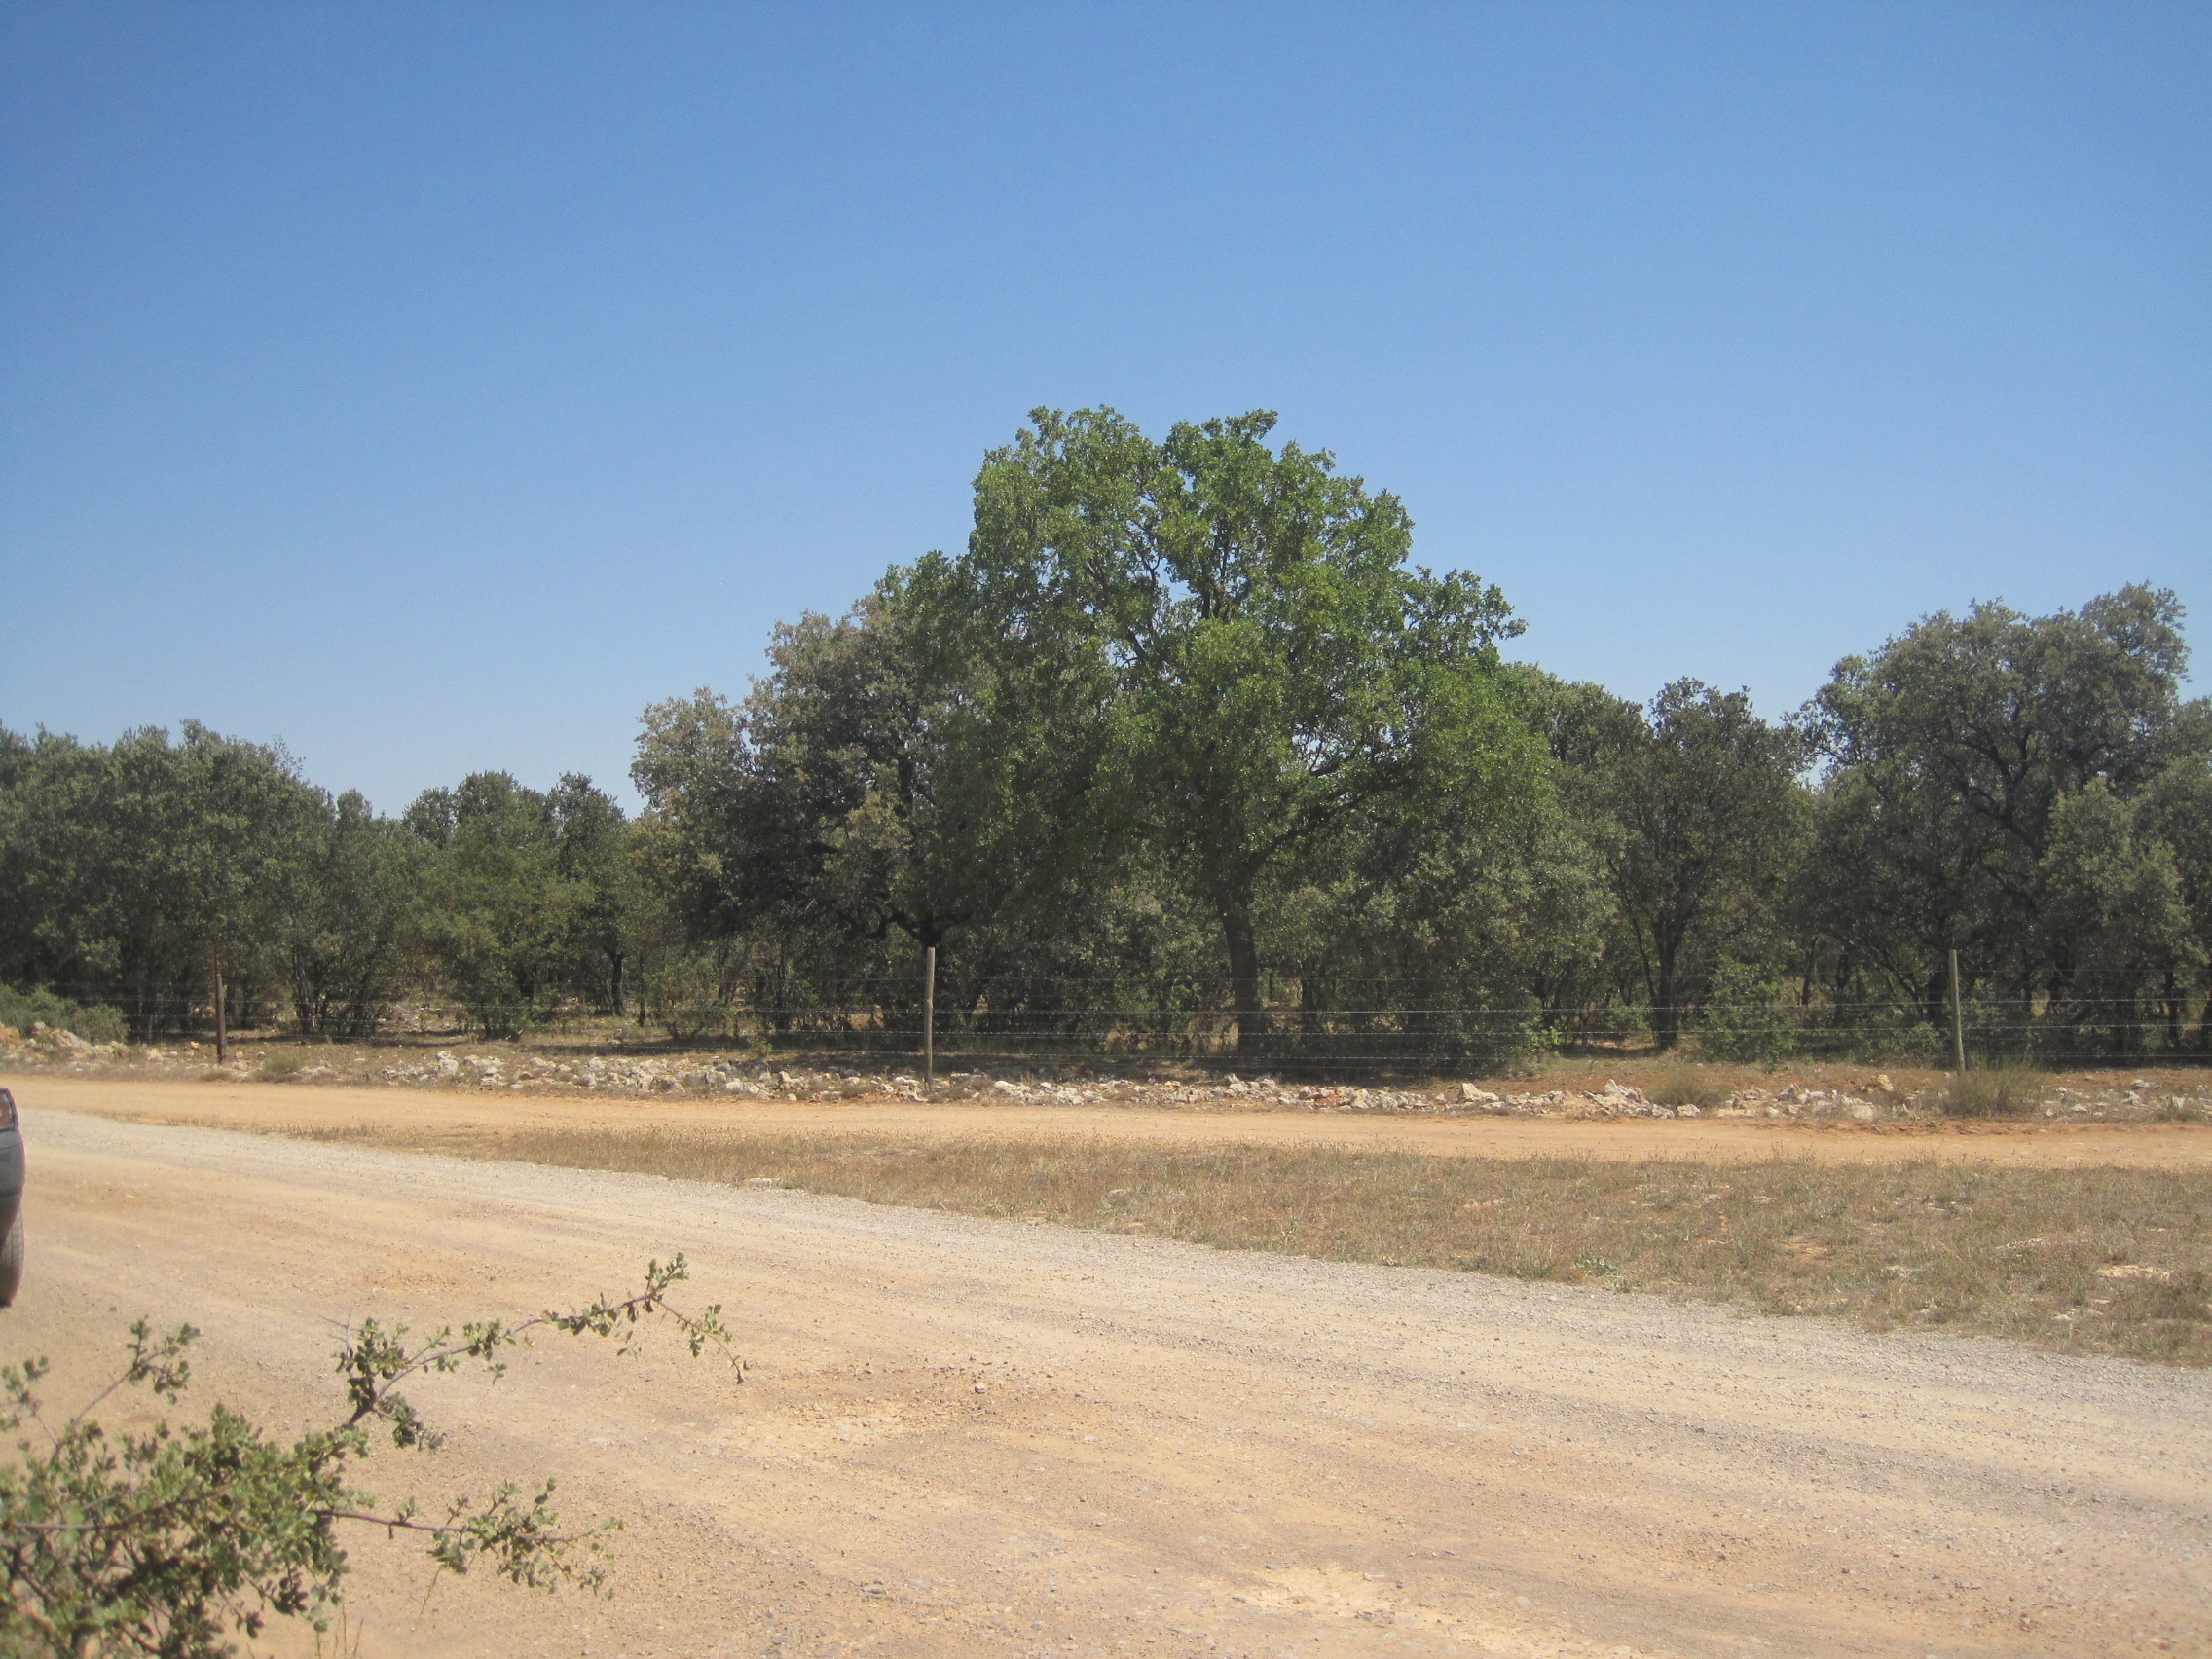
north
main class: Woodland
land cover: Broadleaved woodland
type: broadleaved evergreen forest
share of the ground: 50 - 75 %
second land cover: Grassland without tree/shrub cover
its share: 50 - 75 %
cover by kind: broadleaved forest trees 70 %, herbaceous plants 30 %
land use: Forestry
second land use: Agriculture (excluding fallow land and kitchen gardens)
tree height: > 5 m
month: July
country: ES
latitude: 41.7672
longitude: -5.1262
